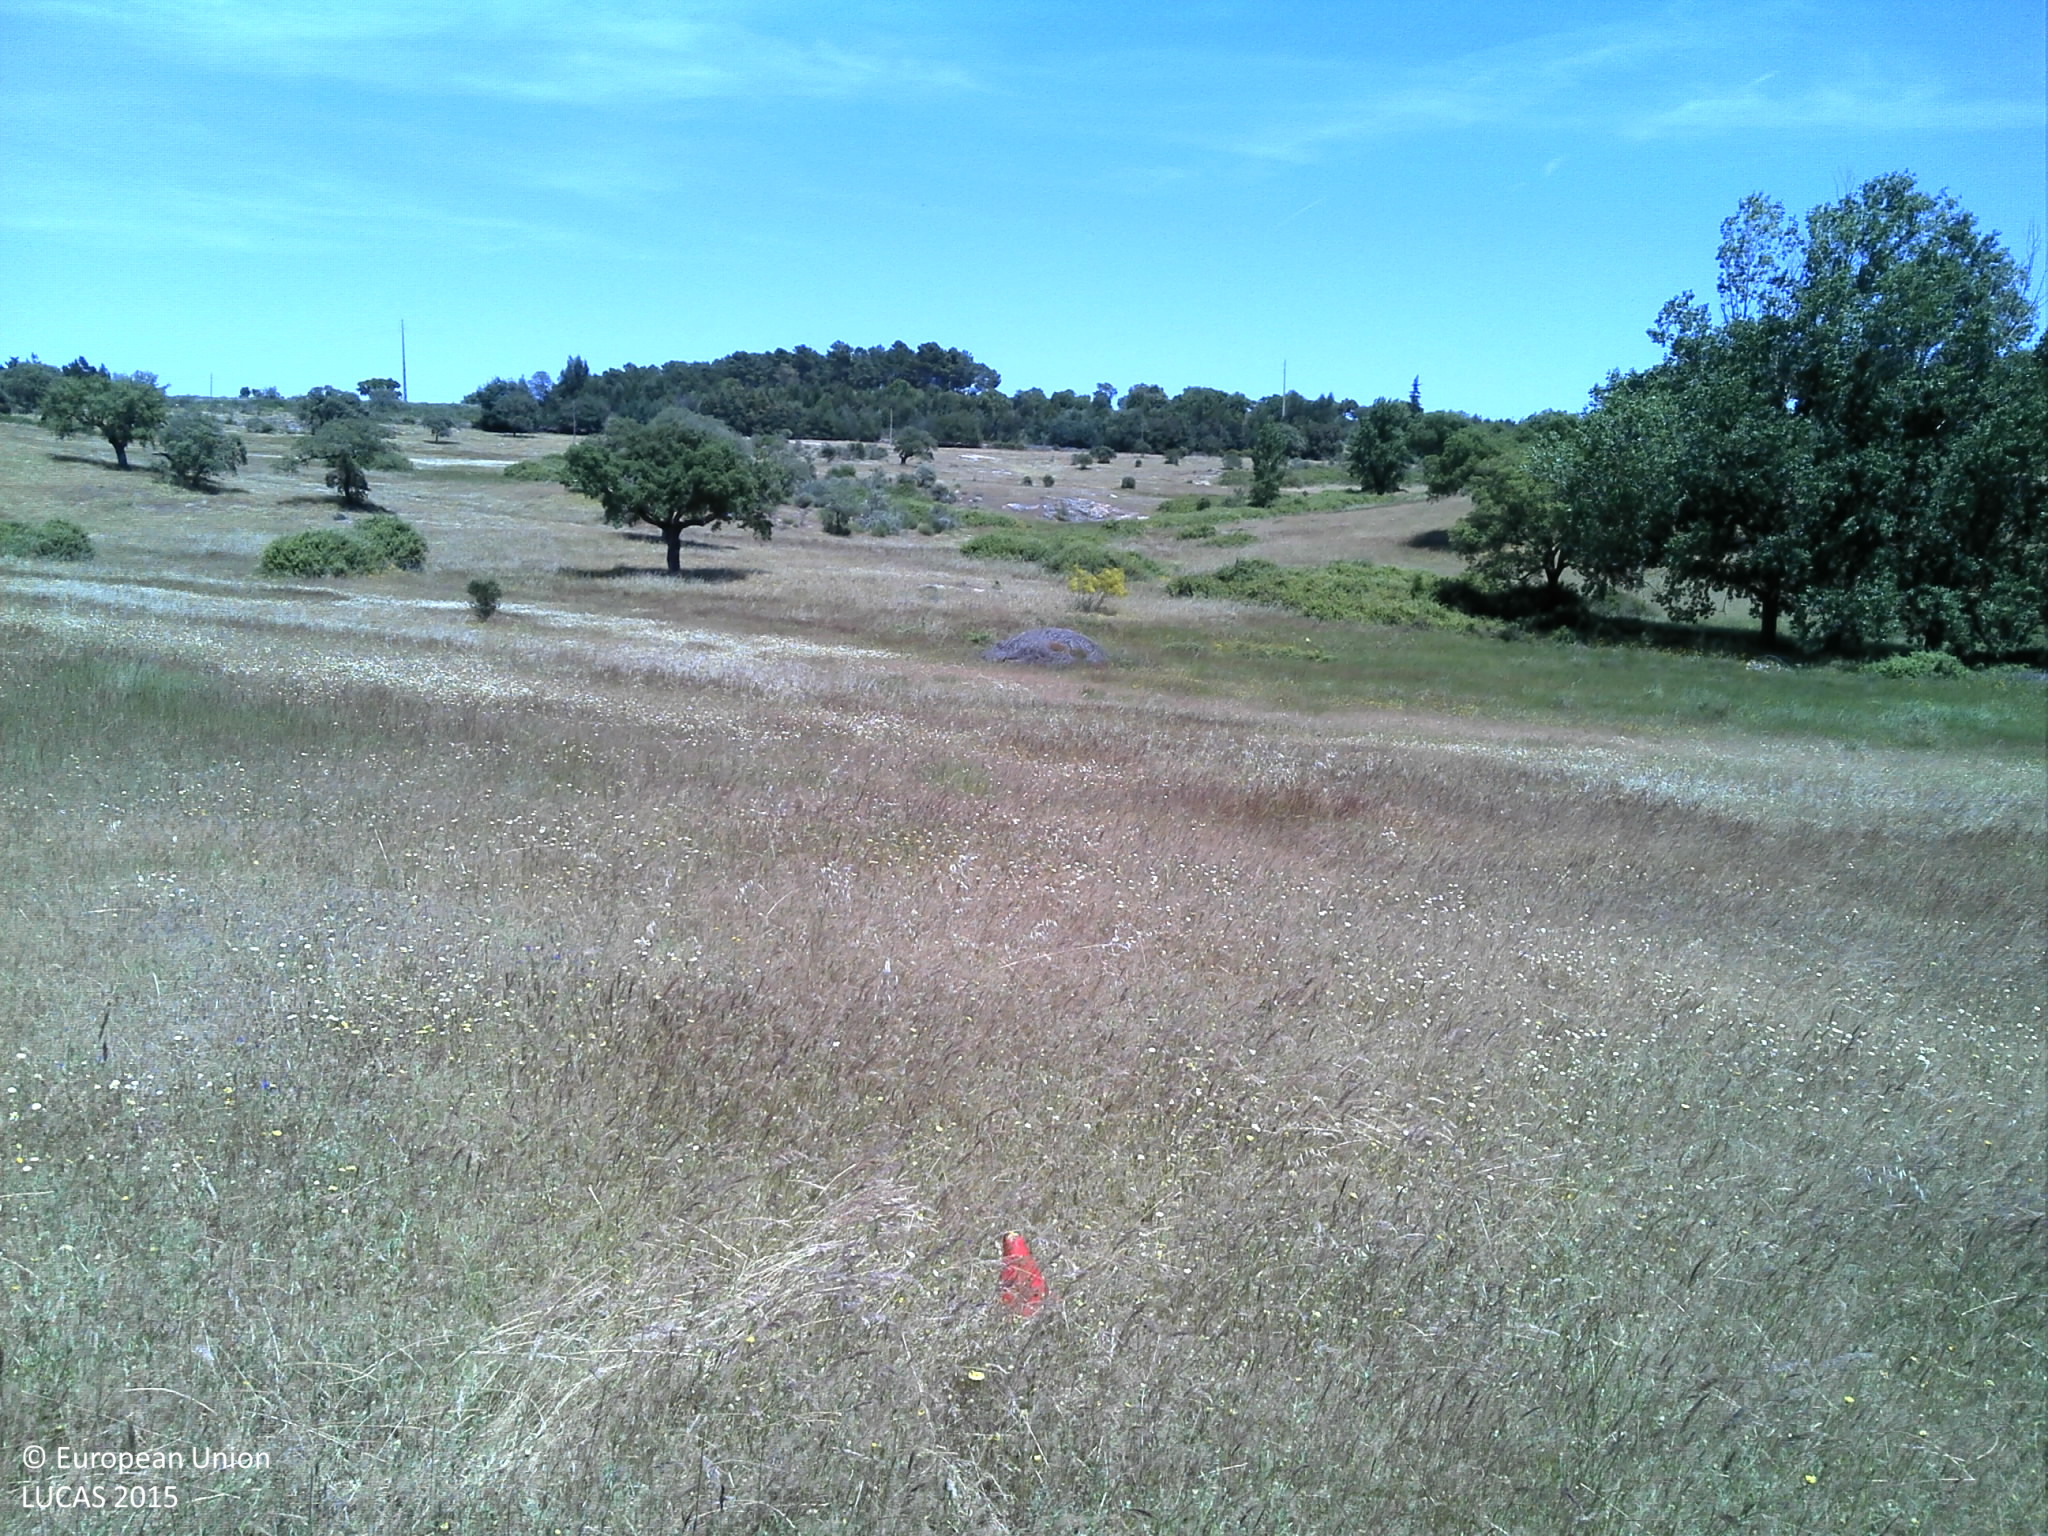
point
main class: Grassland
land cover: Grassland without tree/shrub cover
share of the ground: 50 - 75 %
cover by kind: herbaceous plants 60 %, unconsolidated bare surface 40 %
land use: Agriculture (excluding fallow land and kitchen gardens)
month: May
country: PT
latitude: 39.2973
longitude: -7.6604
